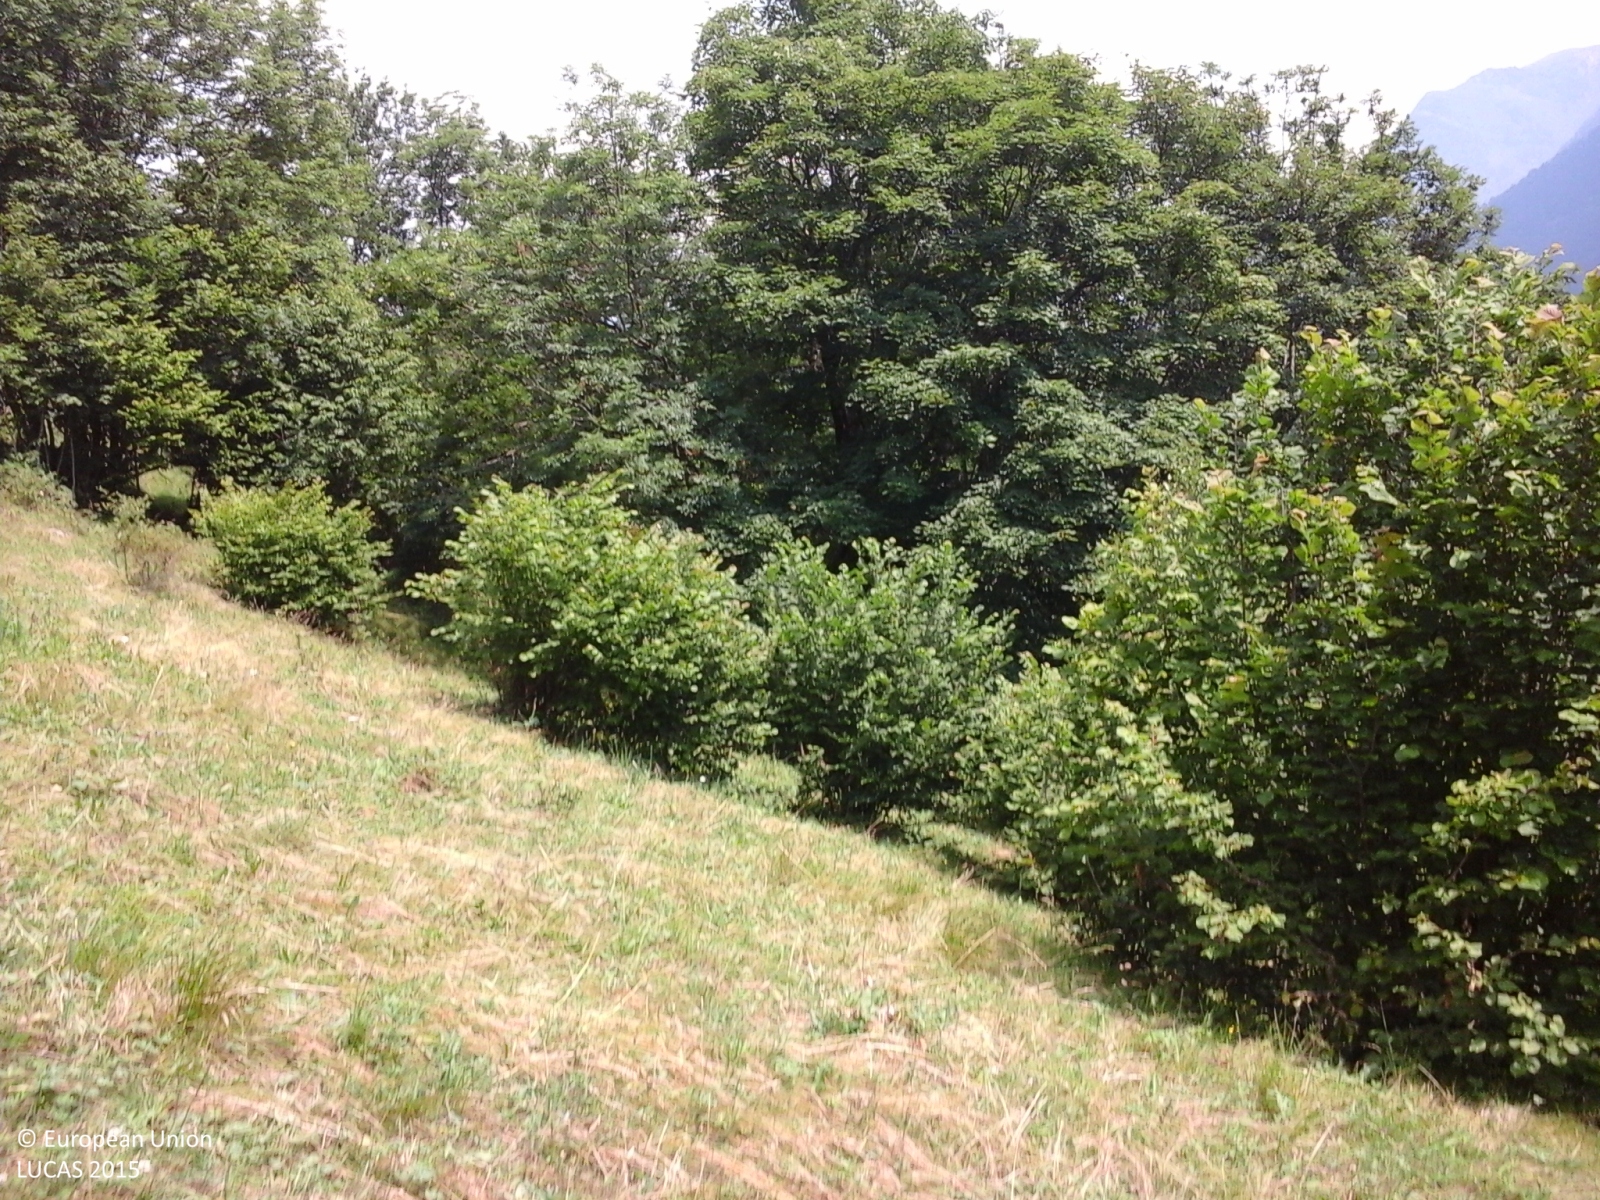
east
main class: Grassland
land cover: Grassland without tree/shrub cover
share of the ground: > 75 %
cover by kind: herbaceous plants 100 %
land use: Agriculture (excluding fallow land and kitchen gardens)
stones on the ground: 10 - 25 %
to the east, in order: Grassland without tree/shrub cover; Broadleaved woodland; Grassland without tree/shrub cover; Broadleaved woodland
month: July
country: IT
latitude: 46.0627
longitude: 10.2453
